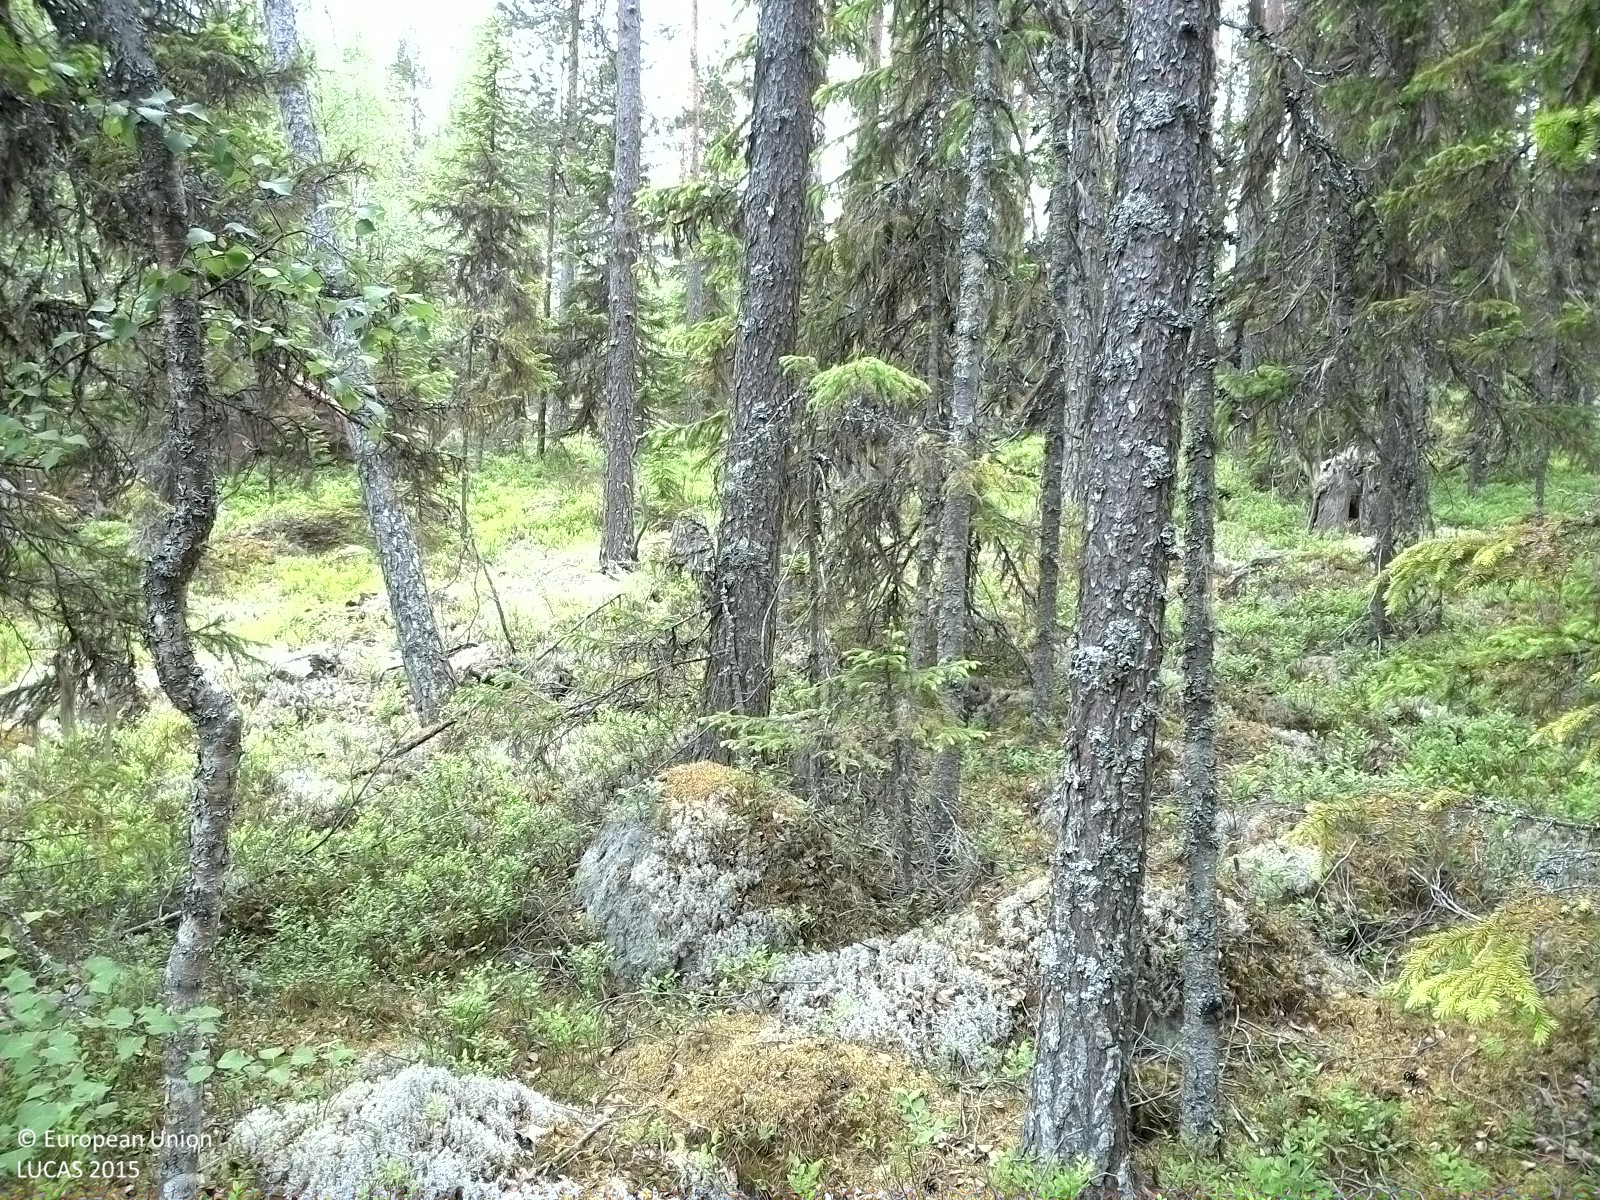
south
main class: Woodland
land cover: Pine dominated coniferous woodland
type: boreal forest
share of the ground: 50 - 75 %
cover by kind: coniferous forest trees 50 %, lichens and mosses 30 %, shrubs 20 %
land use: Forestry
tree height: > 5 m
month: June
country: SE
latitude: 62.0866
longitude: 16.2043
